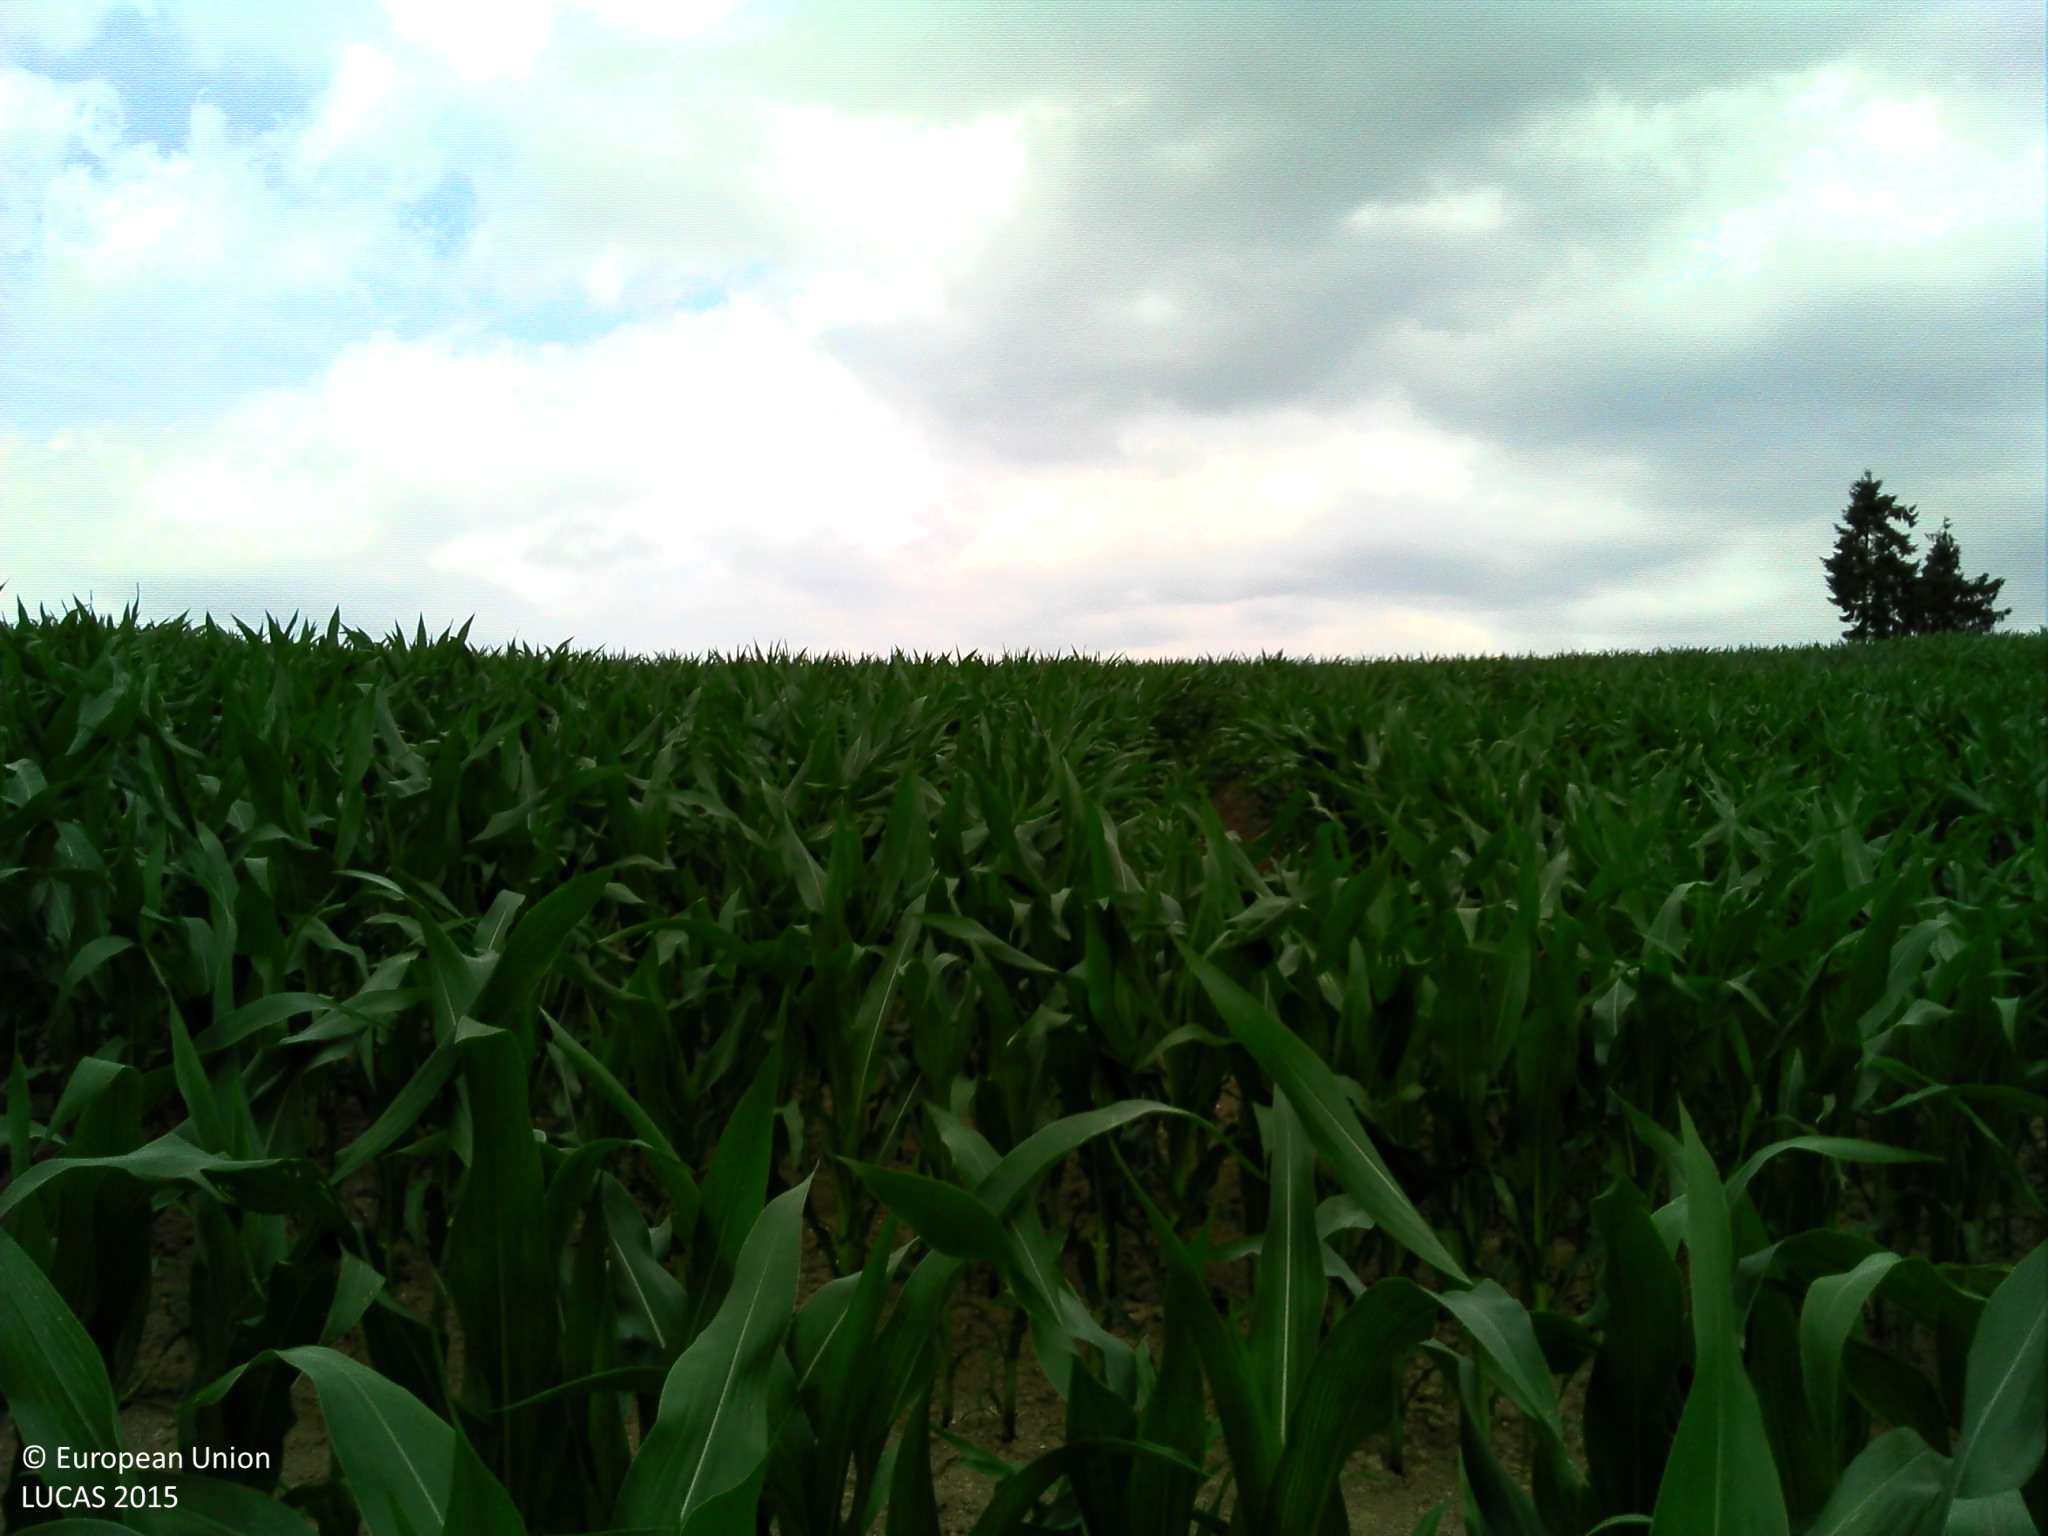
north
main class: Cropland
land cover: Maize
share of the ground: > 75 %
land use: Agriculture (excluding fallow land and kitchen gardens)
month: July
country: FR
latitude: 45.7627
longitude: 1.7781
